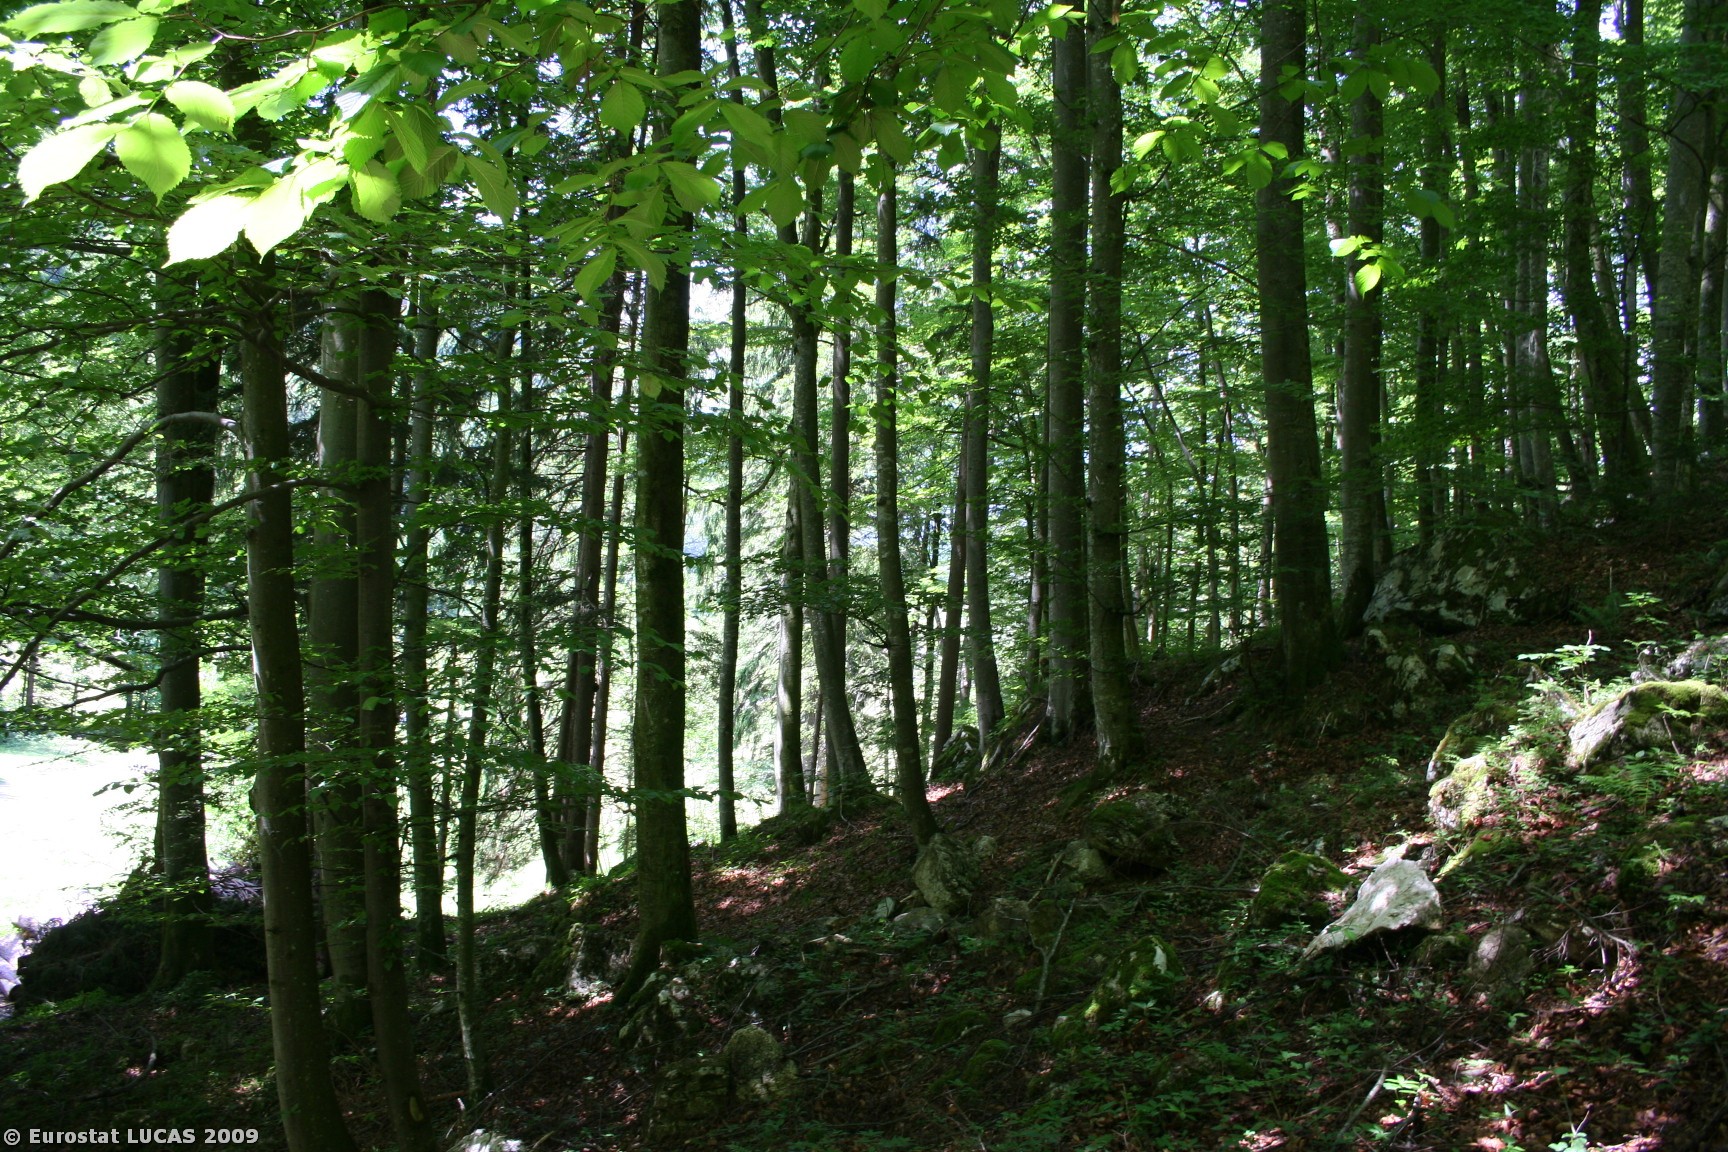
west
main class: Woodland
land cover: Mixed woodland
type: hemiboreal forest and nemoral coniferous forest and mixed broadleaved-coniferous forest
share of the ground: > 75 %
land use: Forestry
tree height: > 5 m
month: May
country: AT
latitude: 47.6007
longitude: 13.2039
